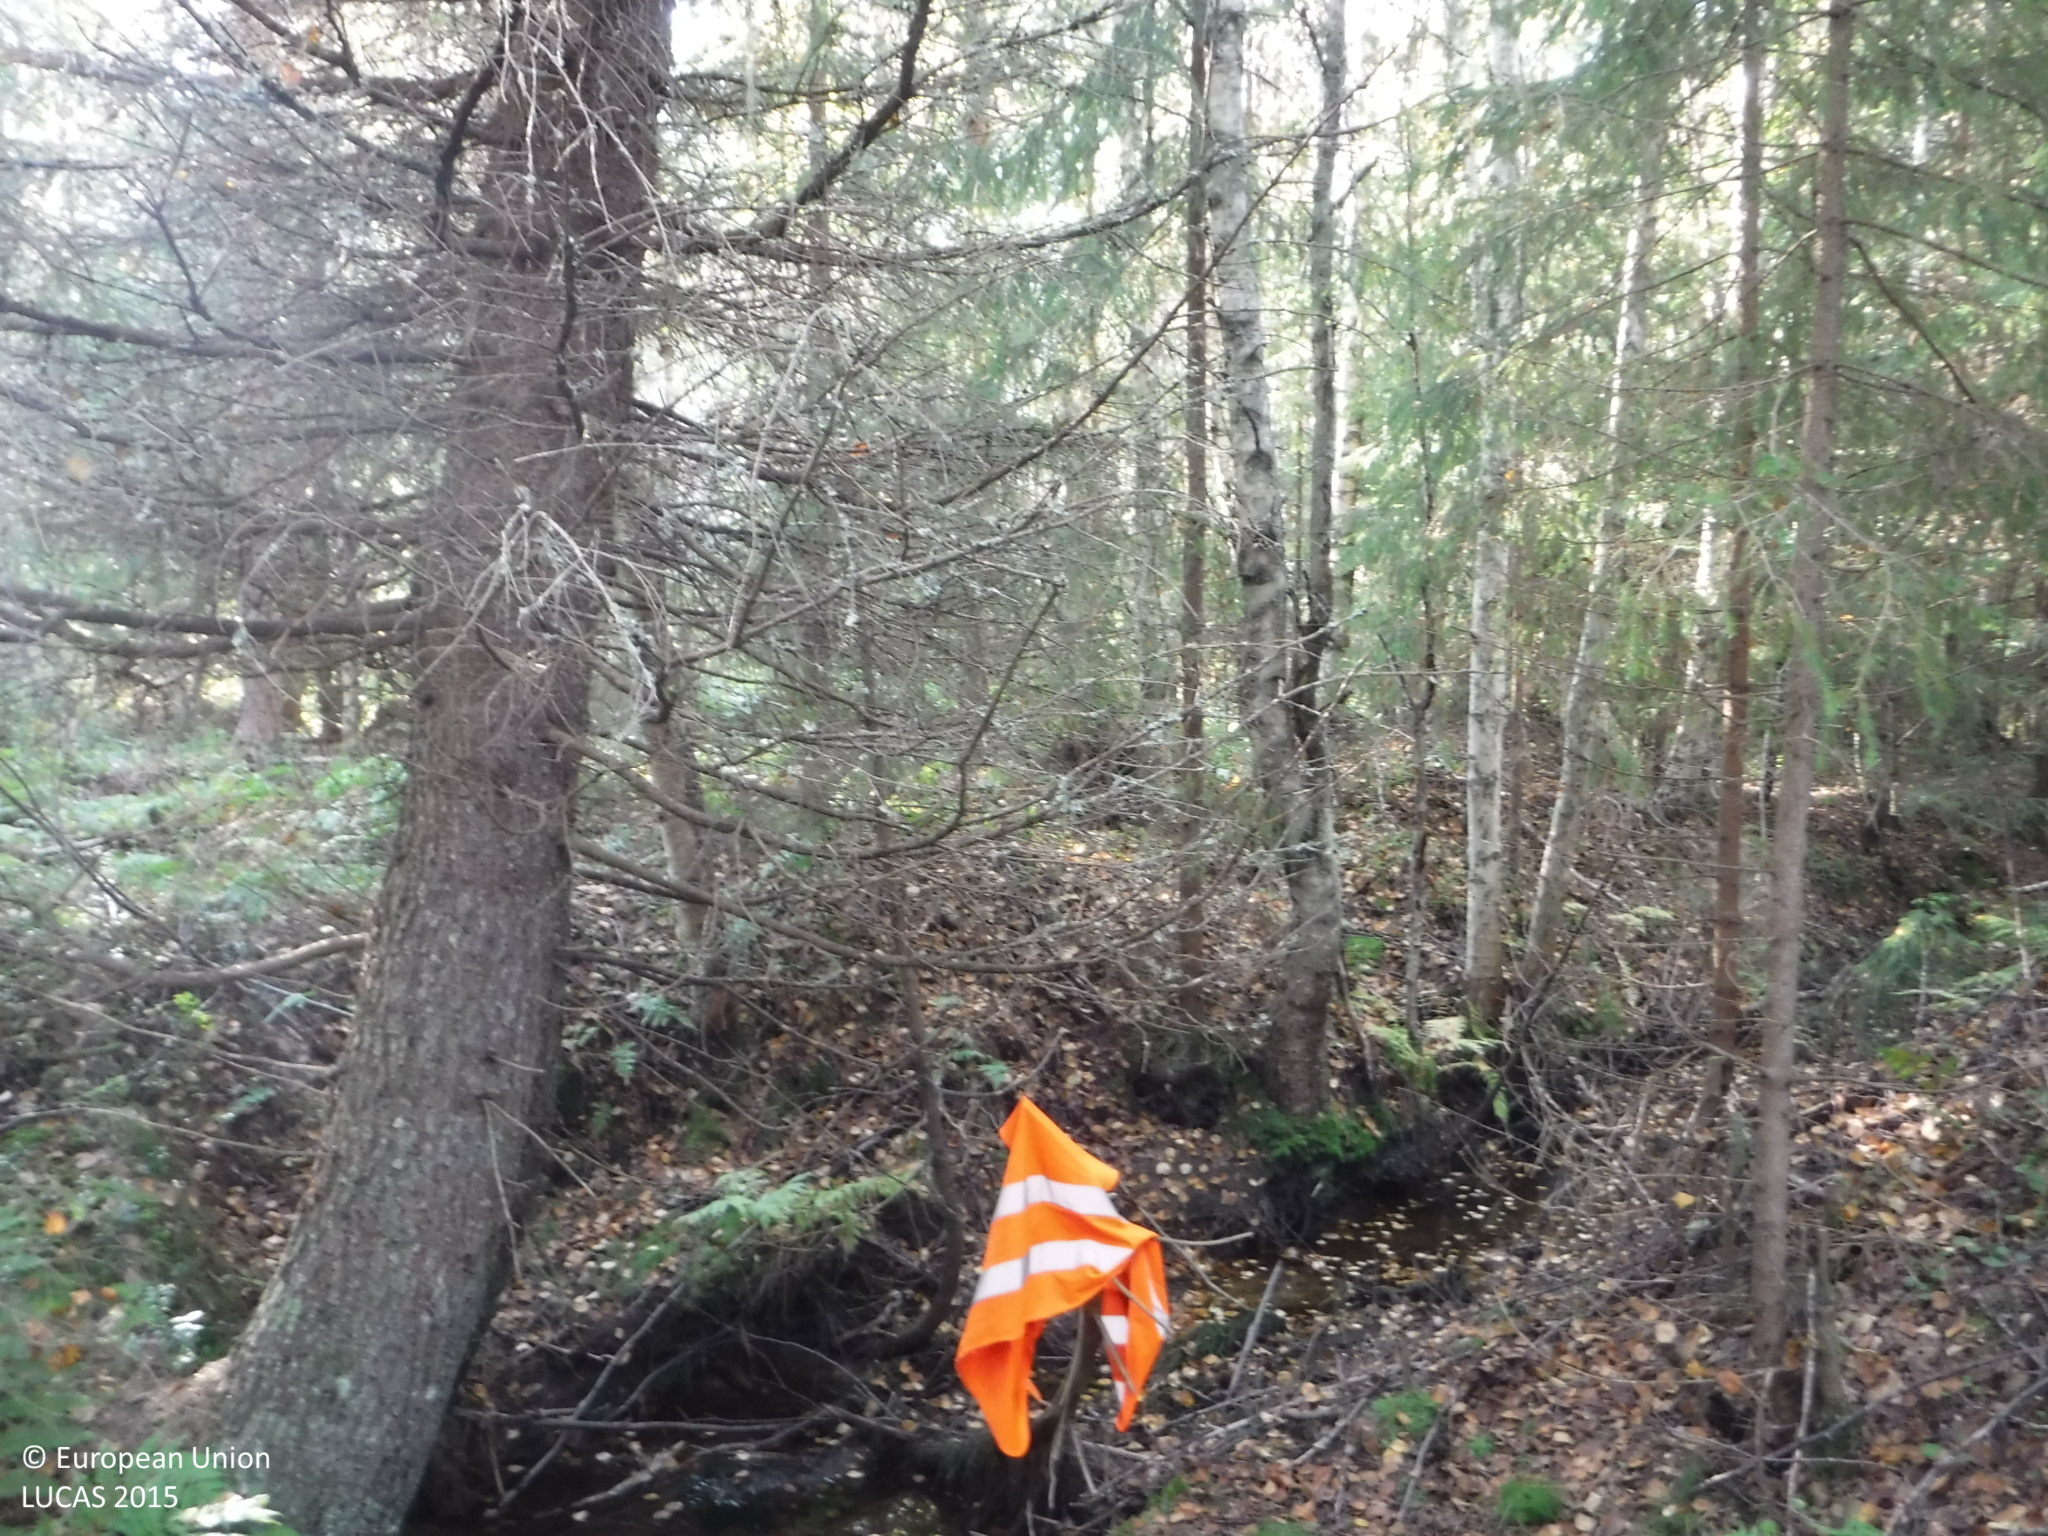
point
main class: Woodland
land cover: Spruce dominated mixed woodland
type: boreal forest
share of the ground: 50 - 75 %
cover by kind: coniferous forest trees 30 %, broadleaved forest trees 30 %, herbaceous plants 30 %, shrubs 5 %, lichens and mosses 5 %
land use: Forestry
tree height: > 5 m
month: September
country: FI
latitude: 61.6836
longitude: 22.7464
